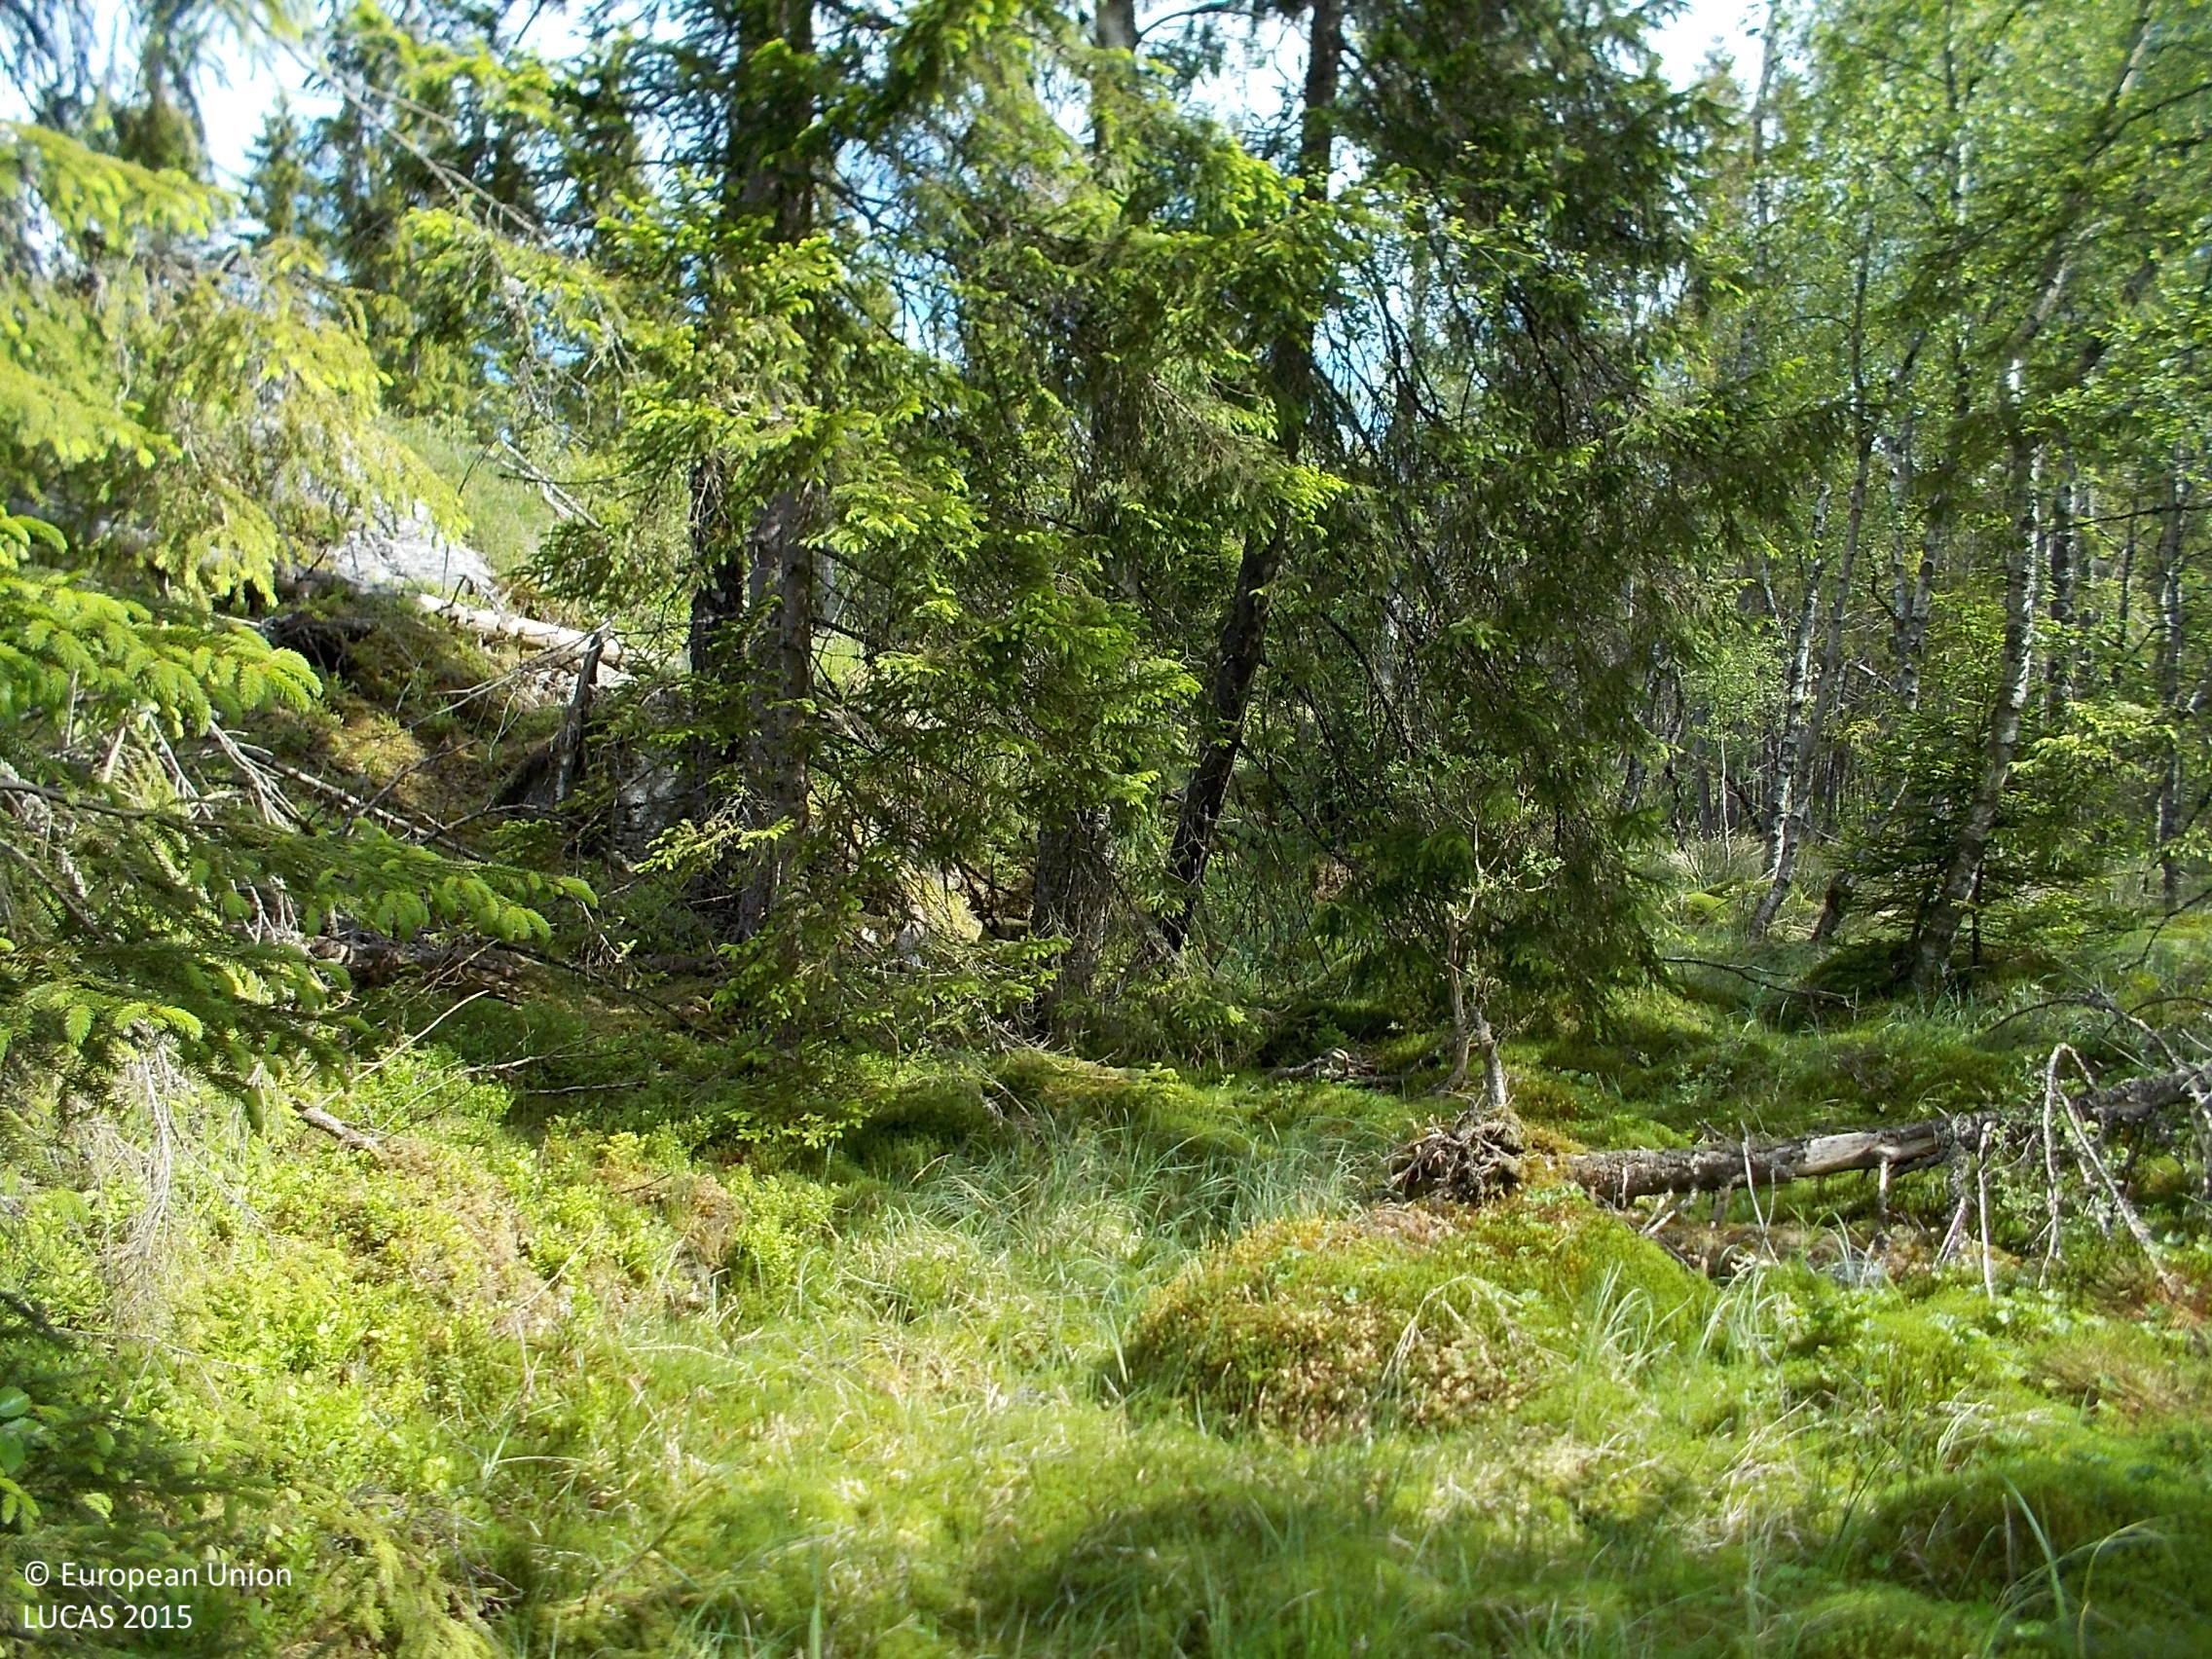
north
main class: Woodland
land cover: Spruce dominated mixed woodland
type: mire and swamp forests
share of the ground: 50 - 75 %
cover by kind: coniferous forest trees 40 %, broadleaved forest trees 20 %, herbaceous plants 20 %, lichens and mosses 20 %
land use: Semi-natural and natural areas not in use
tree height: > 5 m
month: June
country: SE
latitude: 57.6799
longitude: 13.0979
